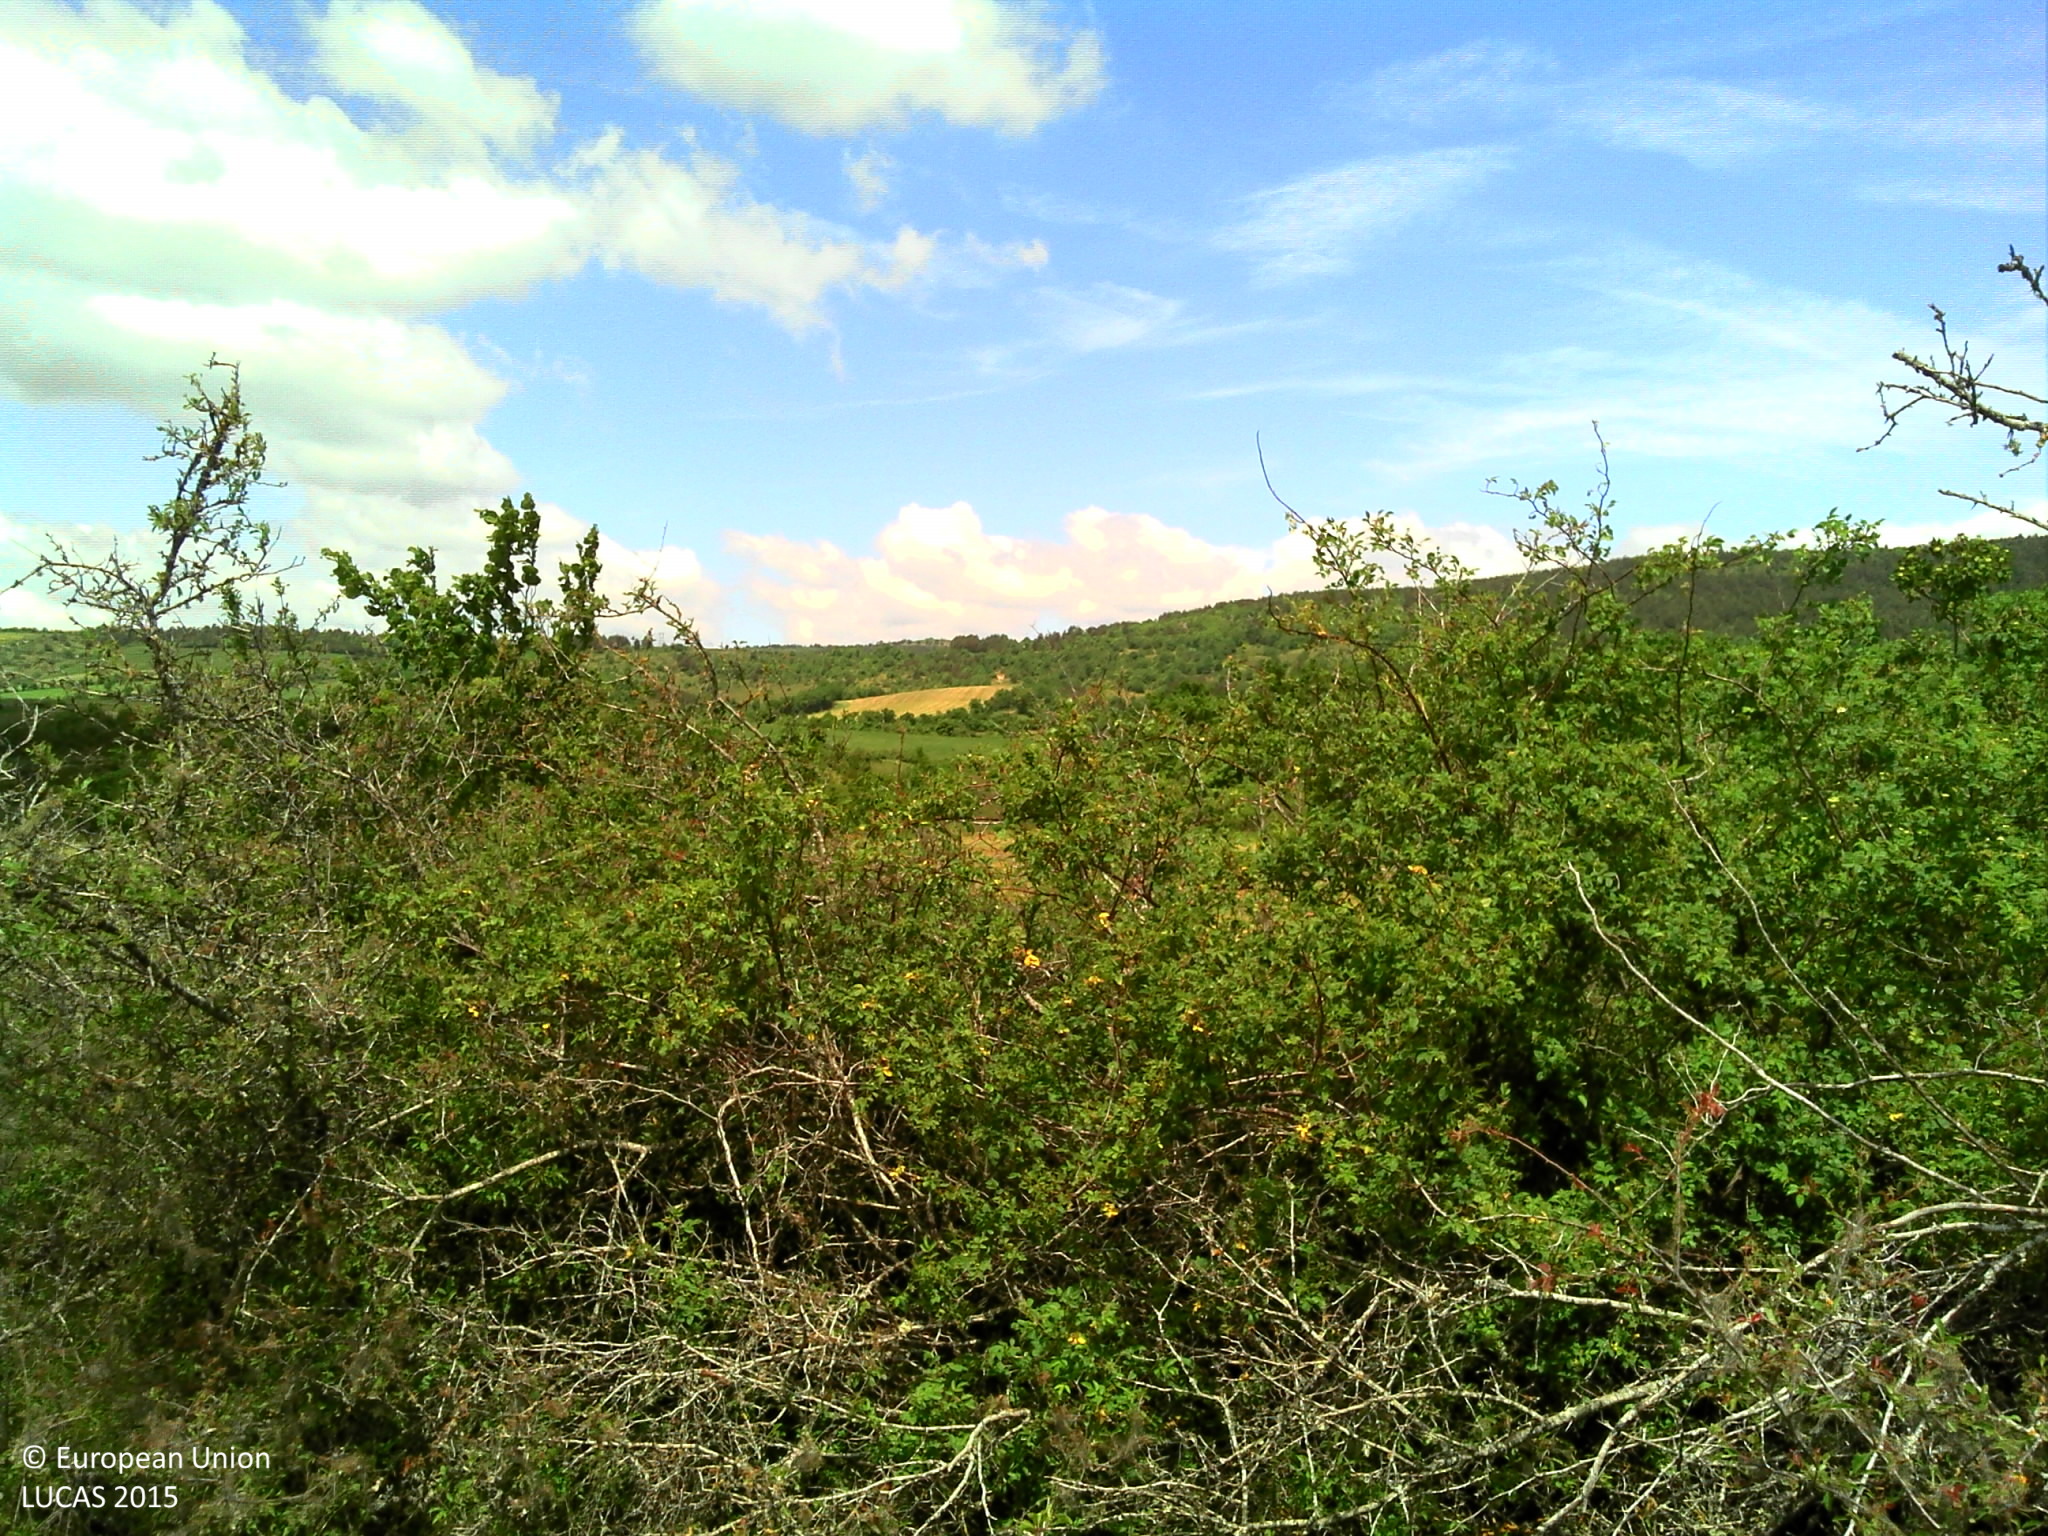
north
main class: Grassland
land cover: Grassland with sparse tree/shrub cover
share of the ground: > 75 %
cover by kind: herbaceous plants 85 %, shrubs 10 %, coniferous forest trees 5 %
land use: Agriculture (excluding fallow land and kitchen gardens)
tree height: < 5 m
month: May
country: FR
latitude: 44.3359
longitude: 3.0693
